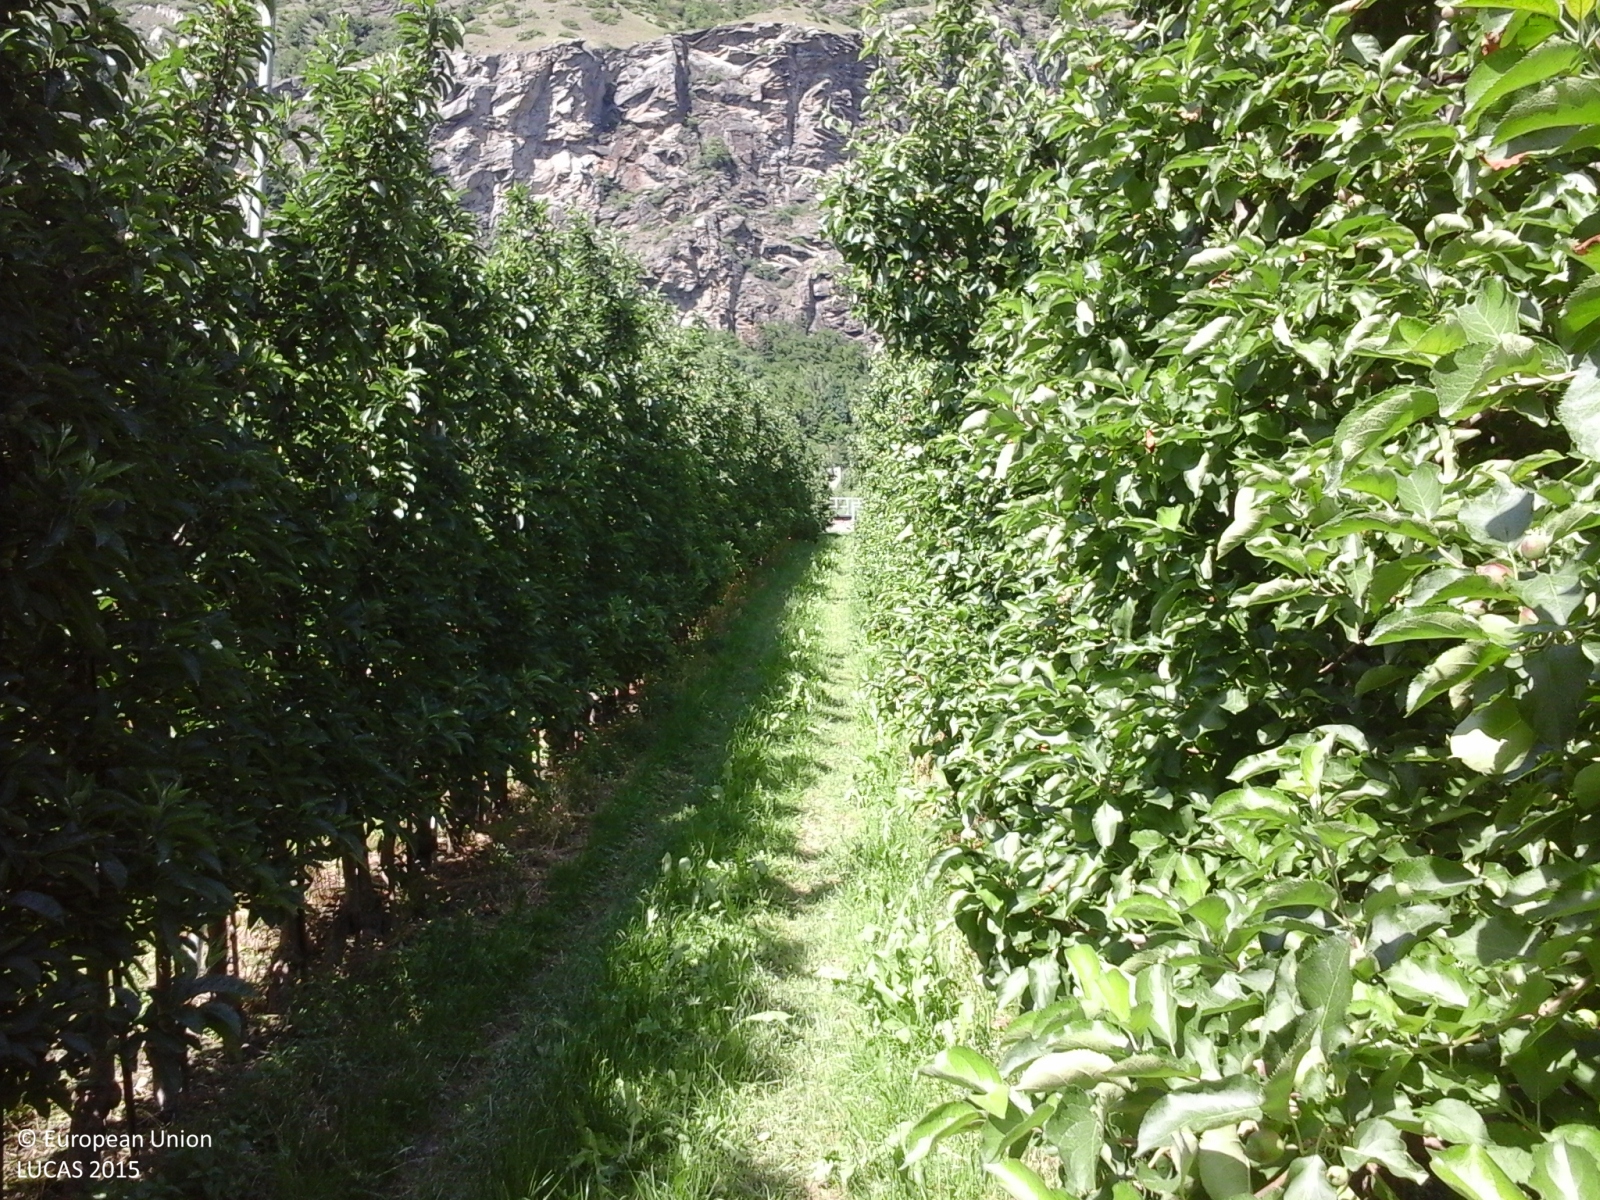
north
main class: Cropland
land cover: Apple fruit
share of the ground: > 75 %
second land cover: Grassland without tree/shrub cover
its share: > 75 %
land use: Agriculture (excluding fallow land and kitchen gardens)
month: May
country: IT
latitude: 46.6180
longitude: 10.8478
